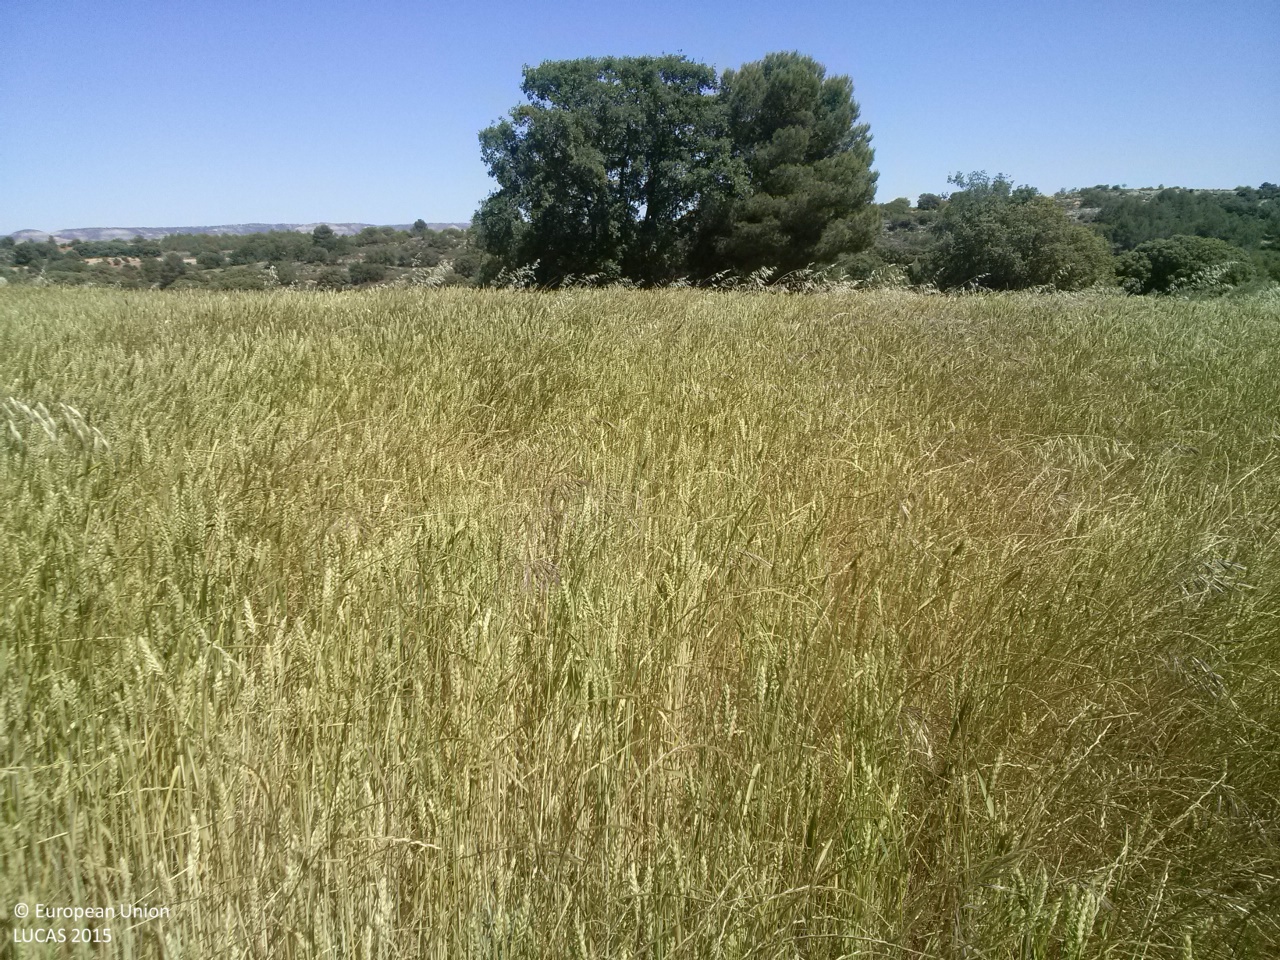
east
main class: Cropland
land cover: Common wheat
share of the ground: > 75 %
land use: Agriculture (excluding fallow land and kitchen gardens)
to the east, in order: Common wheat; Single bushes/trees; Common wheat; Grass margins; Single bushes/trees; Sunflower; Single bushes/trees; Grass margins; Spontaneously vegetated surfaces
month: May
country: ES
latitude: 40.3430
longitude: -2.7749
